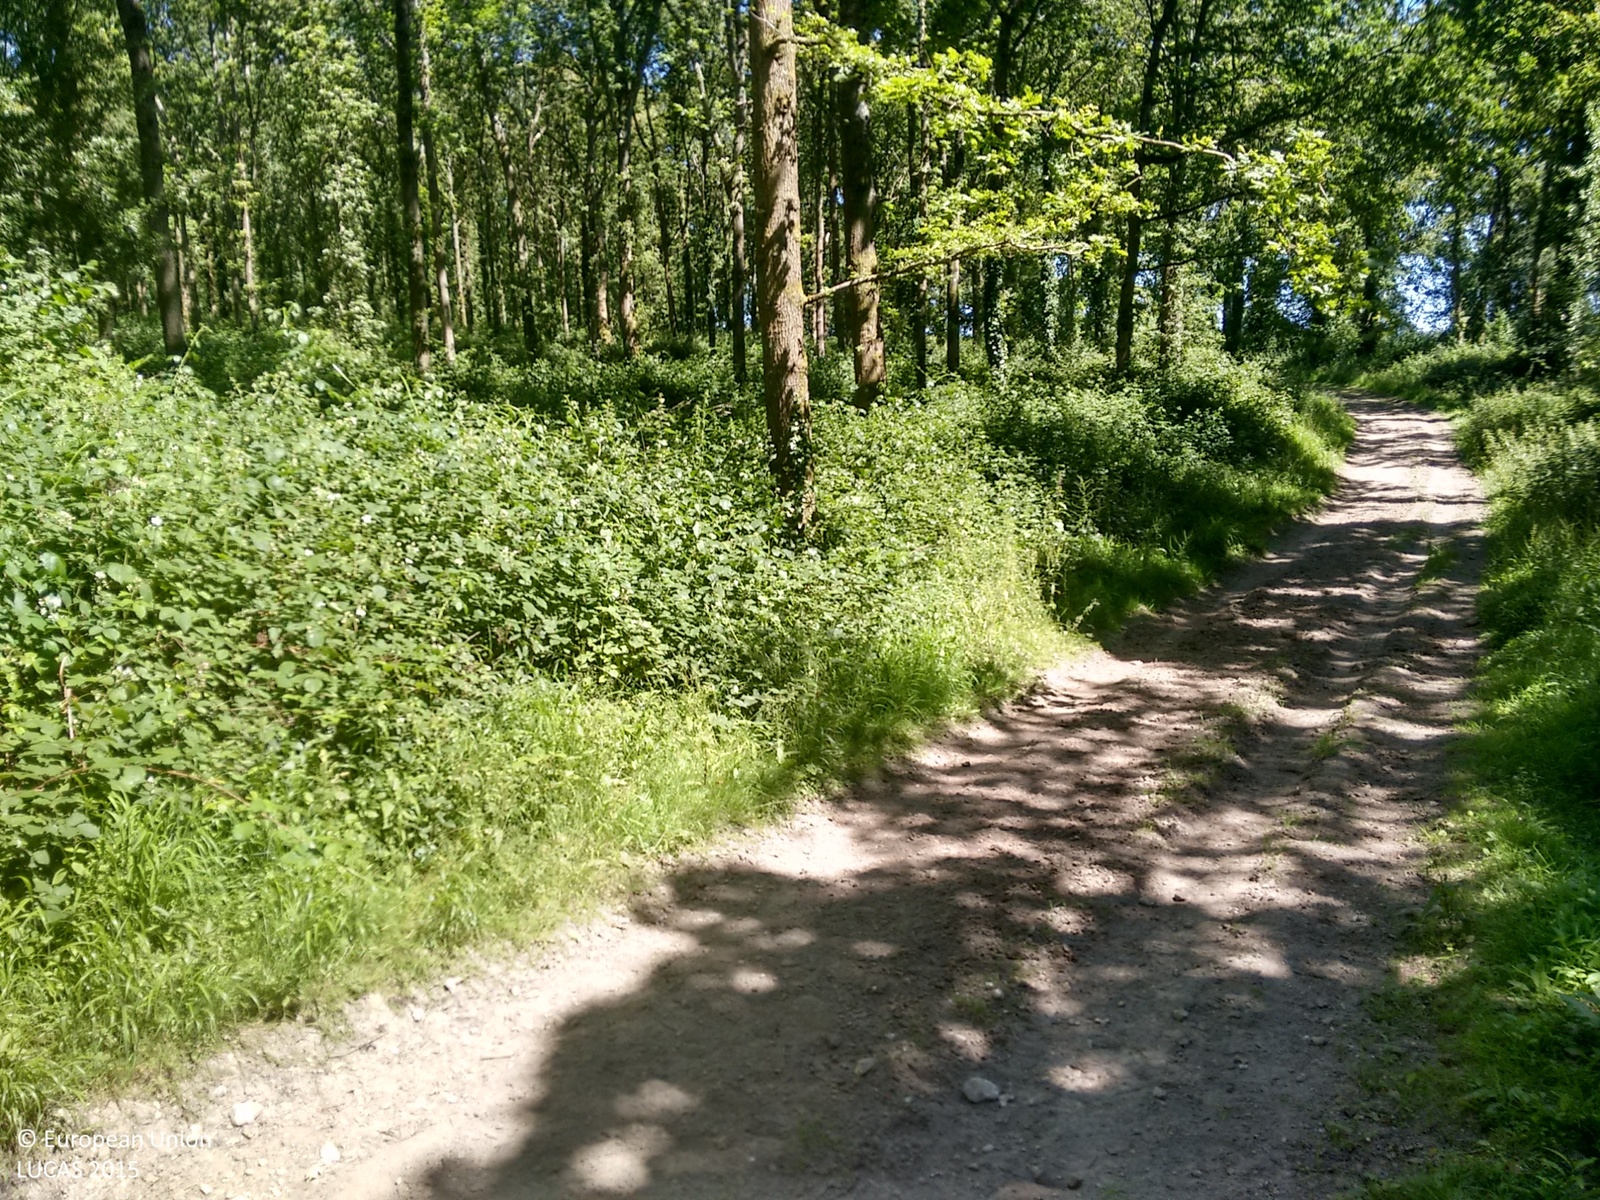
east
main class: Woodland
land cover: Broadleaved woodland
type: mesophytic deciduous forest
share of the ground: > 75 %
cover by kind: broadleaved forest trees 100 %
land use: Forestry
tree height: > 5 m
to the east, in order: Broadleaved woodland; Tracks; Broadleaved woodland; Tracks; Broadleaved woodland; Grass margins; Other fibre and oleaginous crops
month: June
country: GB
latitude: 50.8605
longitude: -0.4802
